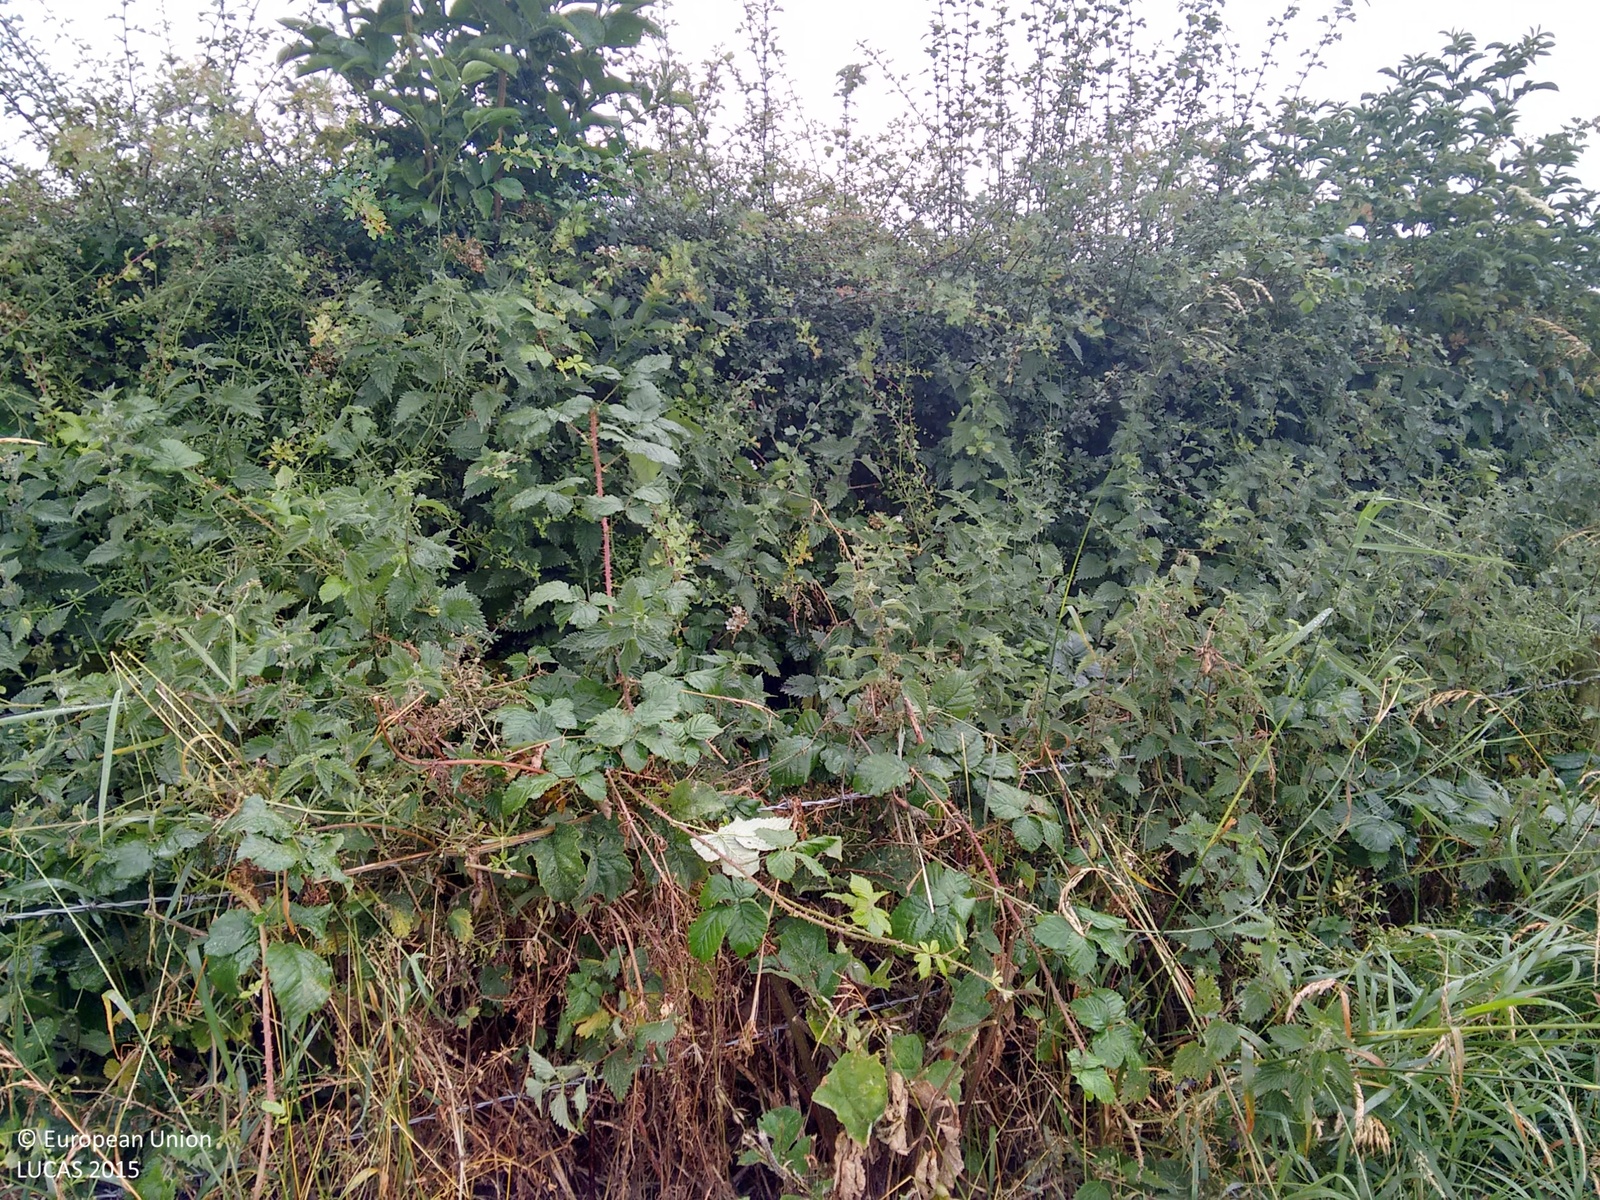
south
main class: Grassland
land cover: Grassland without tree/shrub cover
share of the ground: > 75 %
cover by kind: herbaceous plants 100 %
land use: Agriculture (excluding fallow land and kitchen gardens)
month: July
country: GB
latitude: 52.8158
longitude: -0.9188
